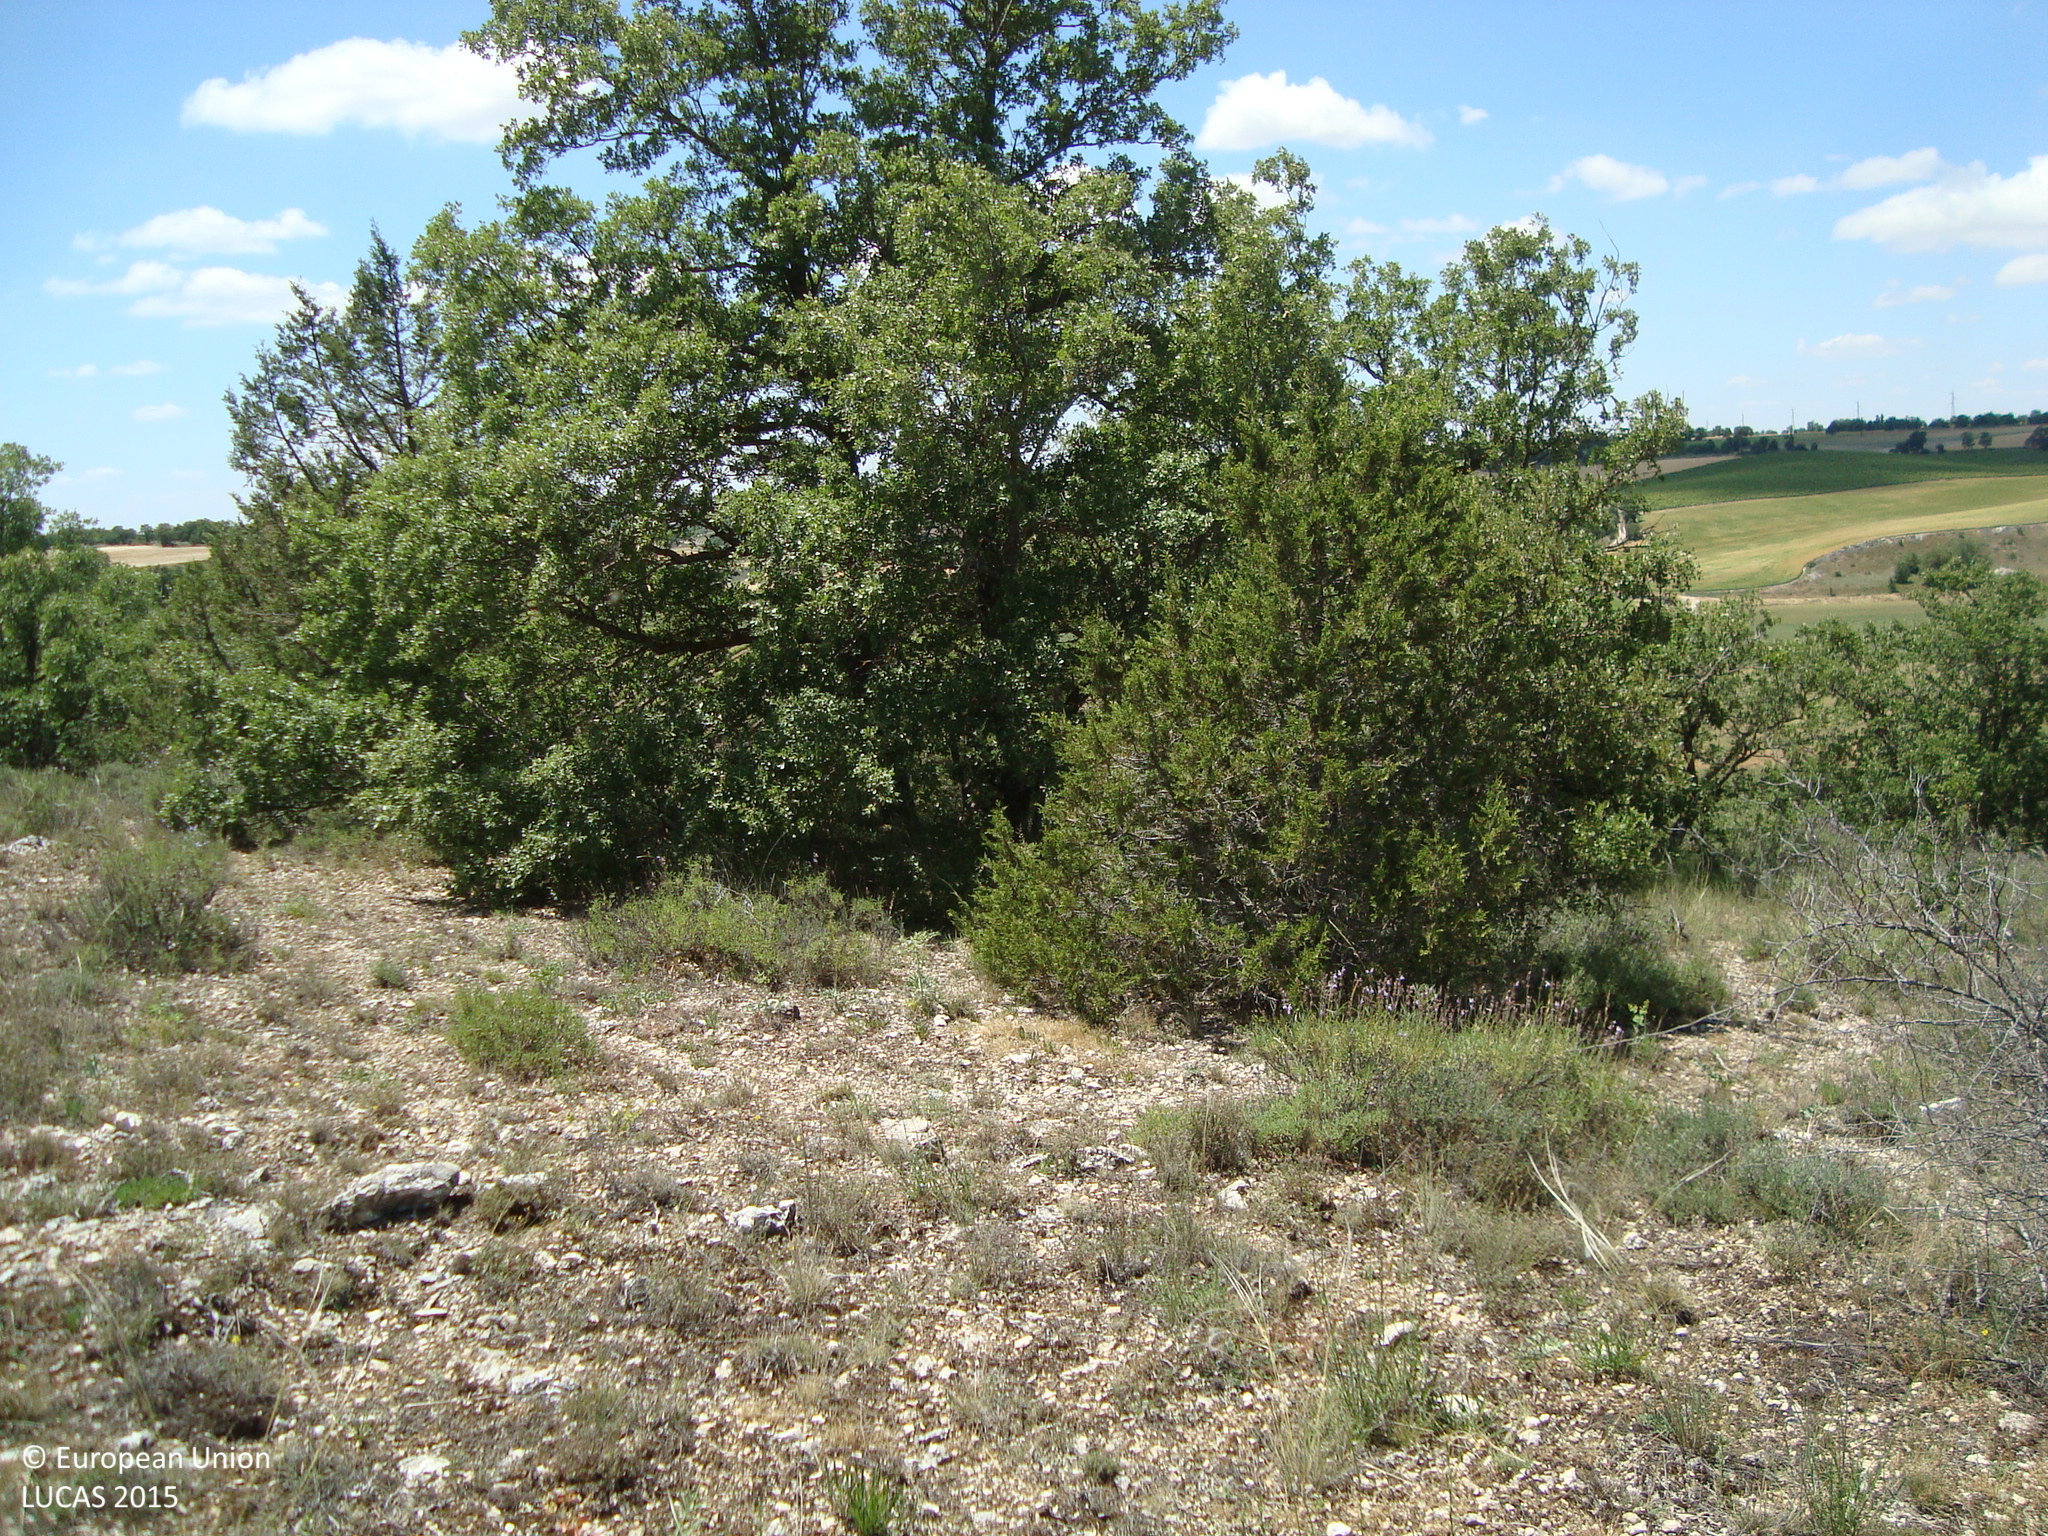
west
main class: Grassland
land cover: Grassland with sparse tree/shrub cover
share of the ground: > 75 %
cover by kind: herbaceous plants 65 %, unconsolidated bare surface 25 %, broadleaved forest trees 5 %, shrubs 5 %
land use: Forestry
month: June
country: ES
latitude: 41.6986
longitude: -4.2285
